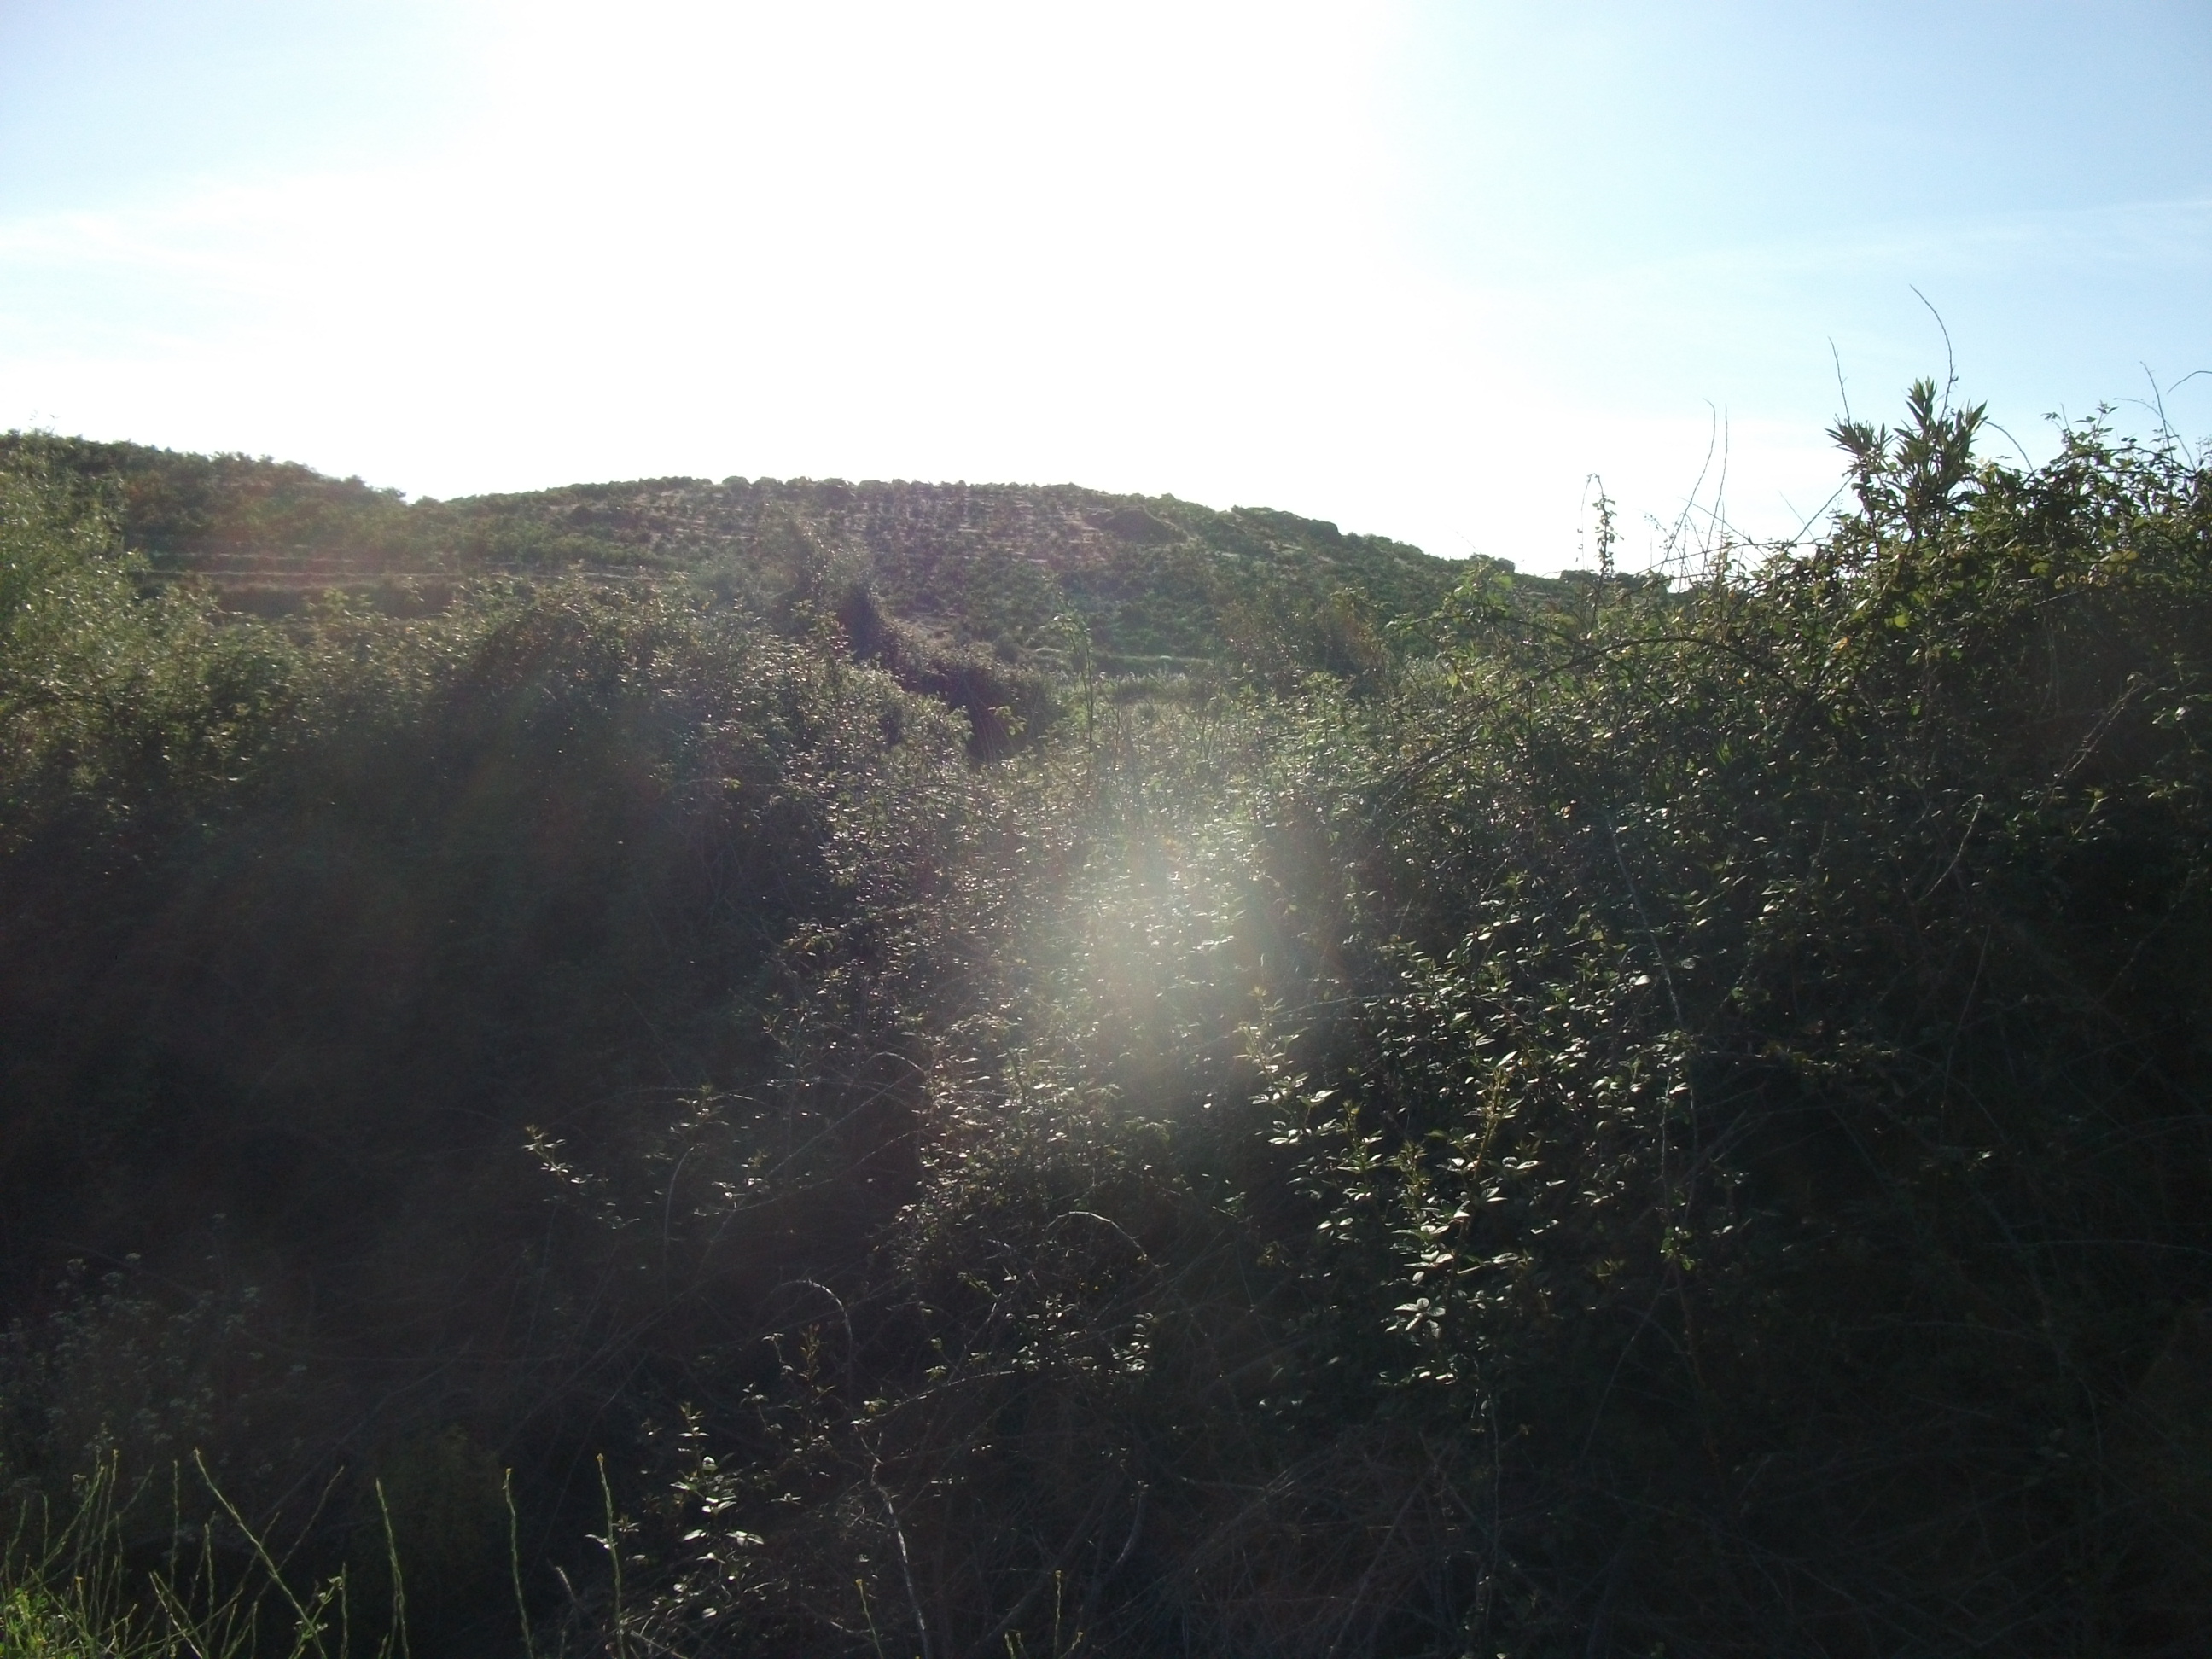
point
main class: Shrubland
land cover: Shrubland without tree cover
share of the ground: > 75 %
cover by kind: shrubs 100 %
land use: Semi-natural and natural areas not in use
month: April
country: ES
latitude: 37.6616
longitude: -6.6016
